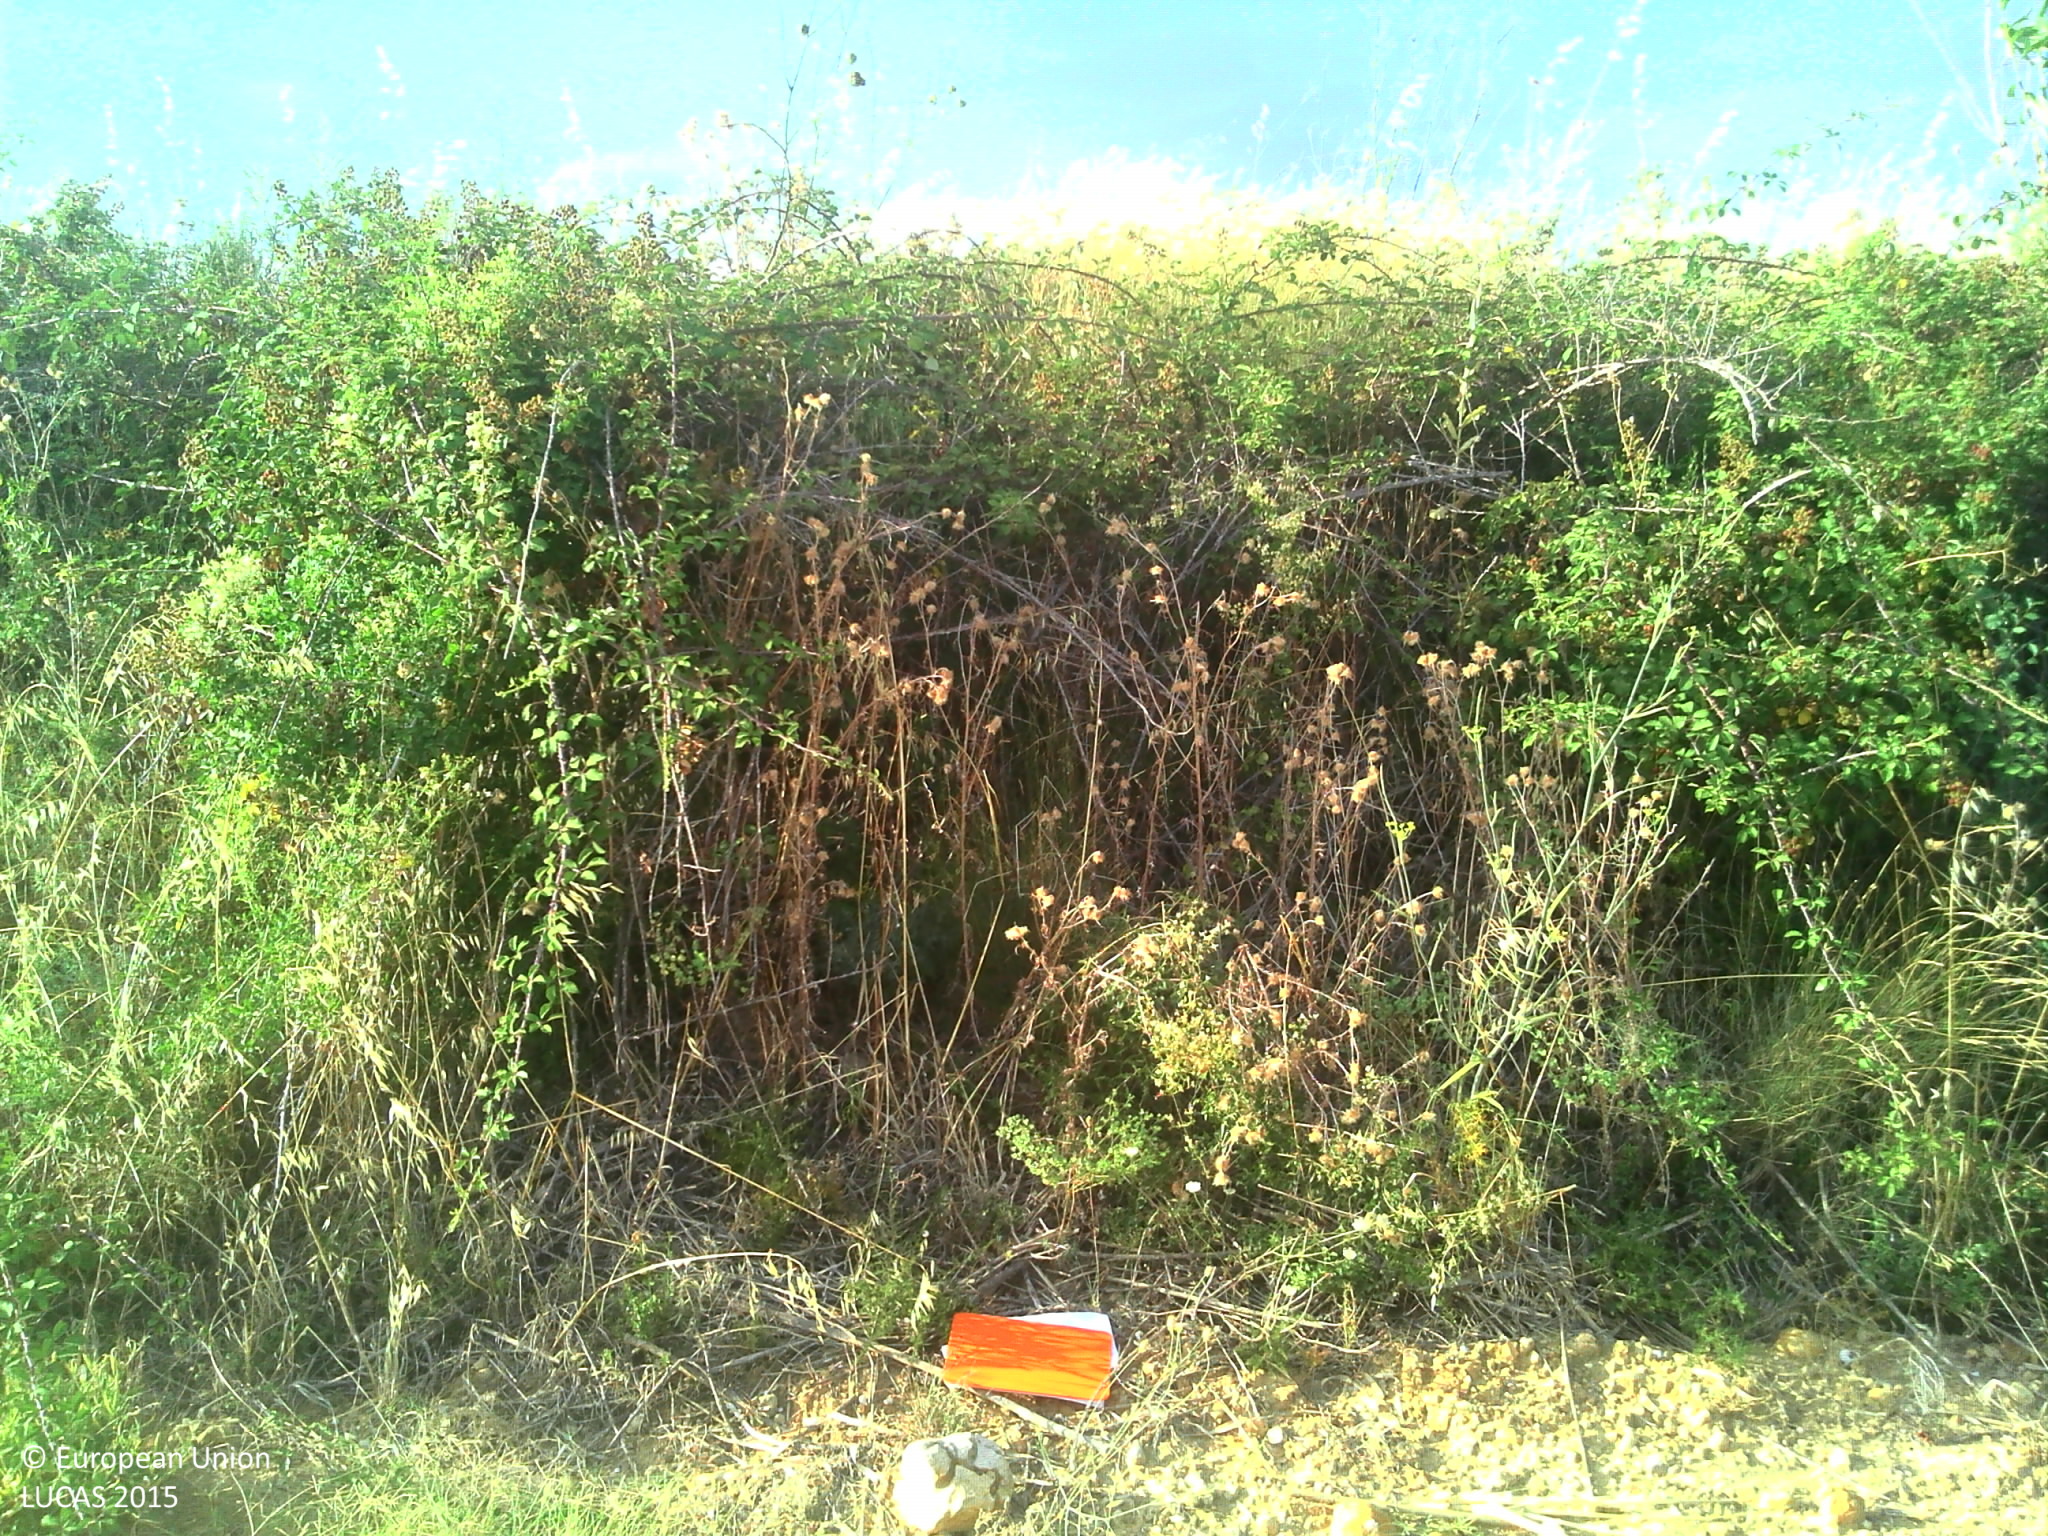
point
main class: Grassland
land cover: Spontaneously vegetated surfaces
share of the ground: > 75 %
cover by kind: herbaceous plants 90 %, shrubs 5 %, lichens and mosses 5 %
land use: Abandoned areas
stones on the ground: 25 - 50 %
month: July
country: FR
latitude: 43.3955
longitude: 3.0827
